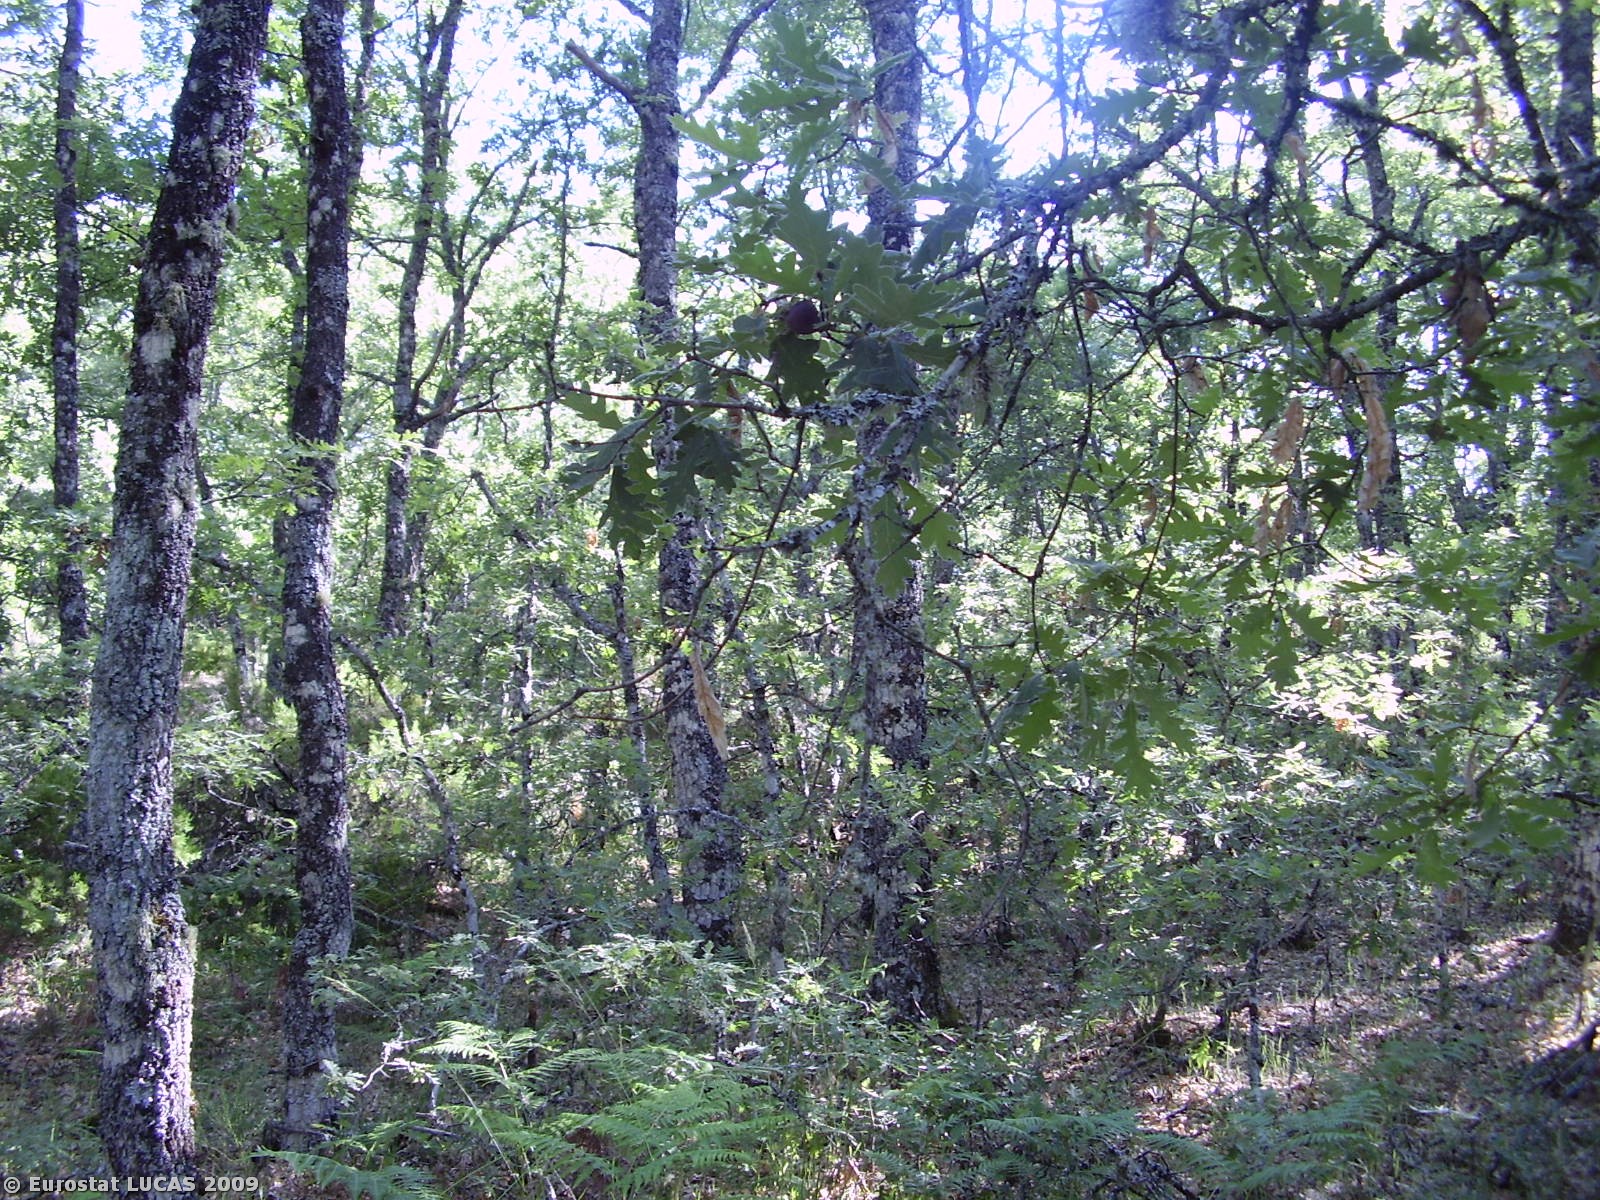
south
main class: Woodland
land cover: Broadleaved woodland
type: thermophilous deciduous forest
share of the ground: 50 - 75 %
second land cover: Spontaneously vegetated surfaces
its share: 25 - 50 %
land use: Forestry
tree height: > 5 m
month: June
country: PT
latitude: 41.8541
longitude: -6.9705
